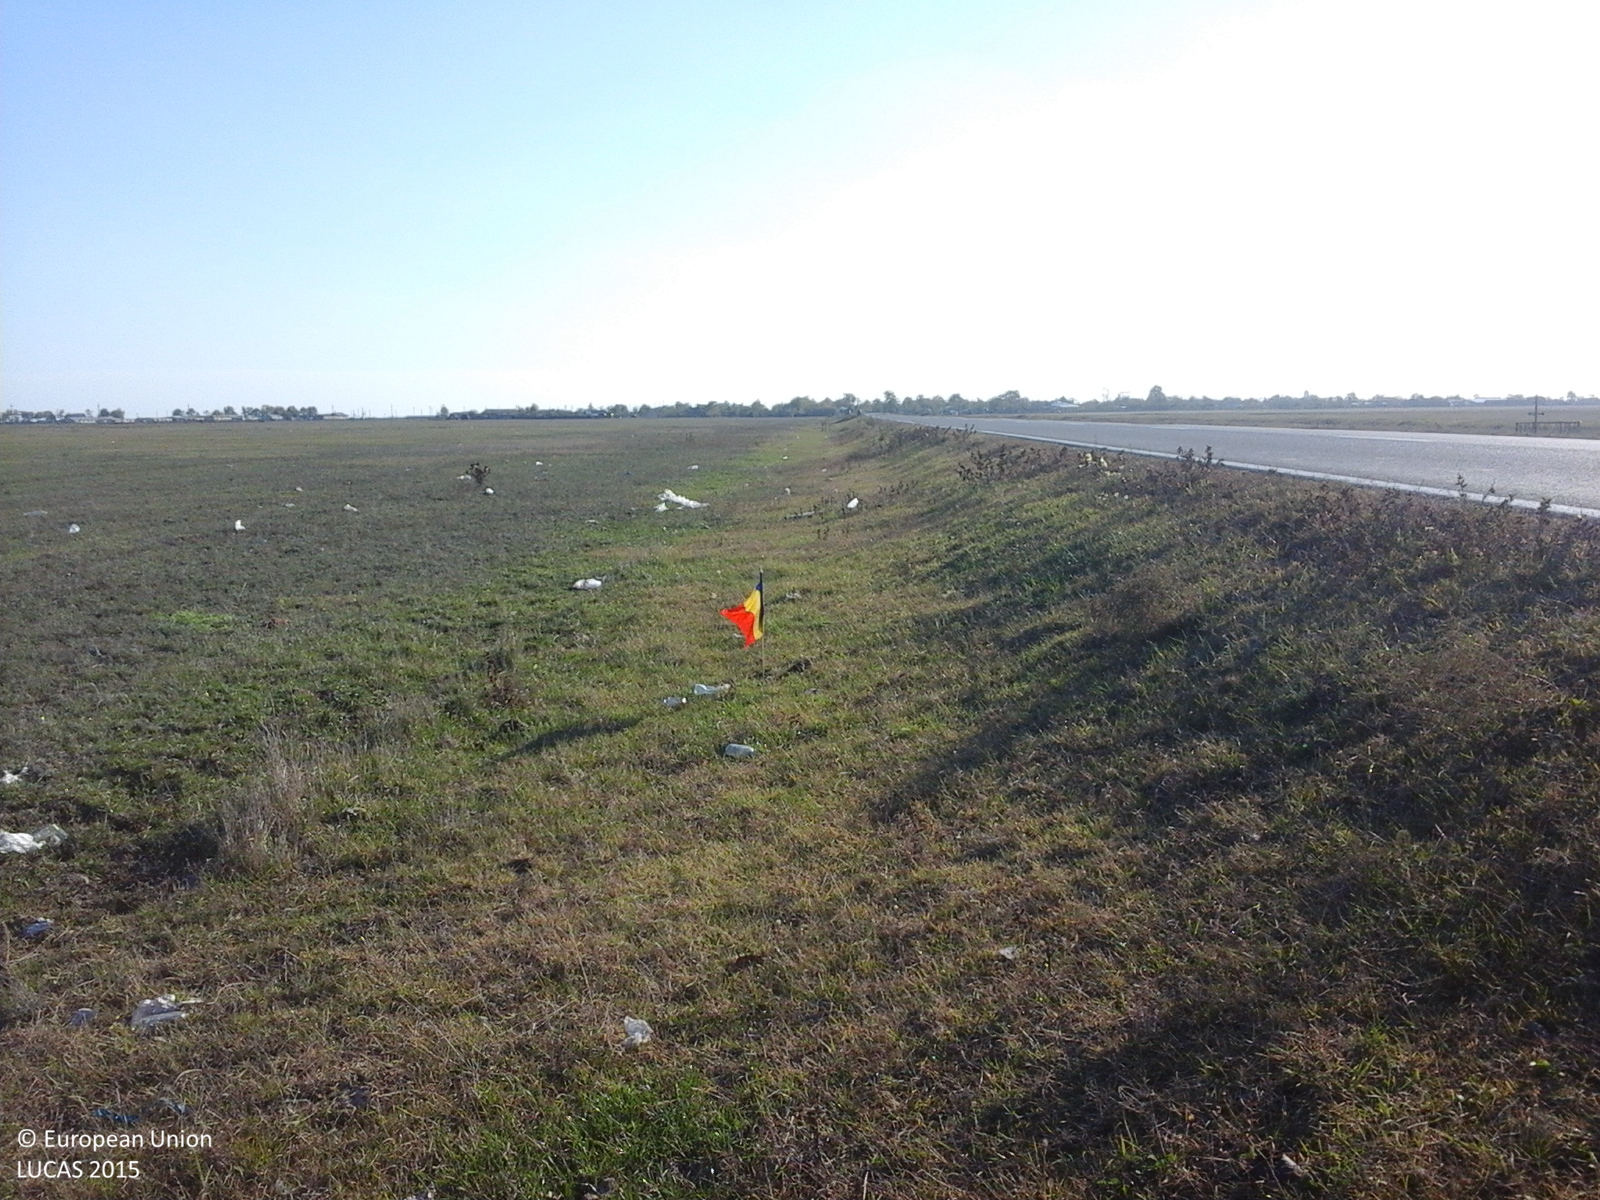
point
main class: Grassland
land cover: Grassland without tree/shrub cover
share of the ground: > 75 %
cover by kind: herbaceous plants 100 %
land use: Agriculture (excluding fallow land and kitchen gardens)
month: October
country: RO
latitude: 45.4417
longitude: 27.5279
